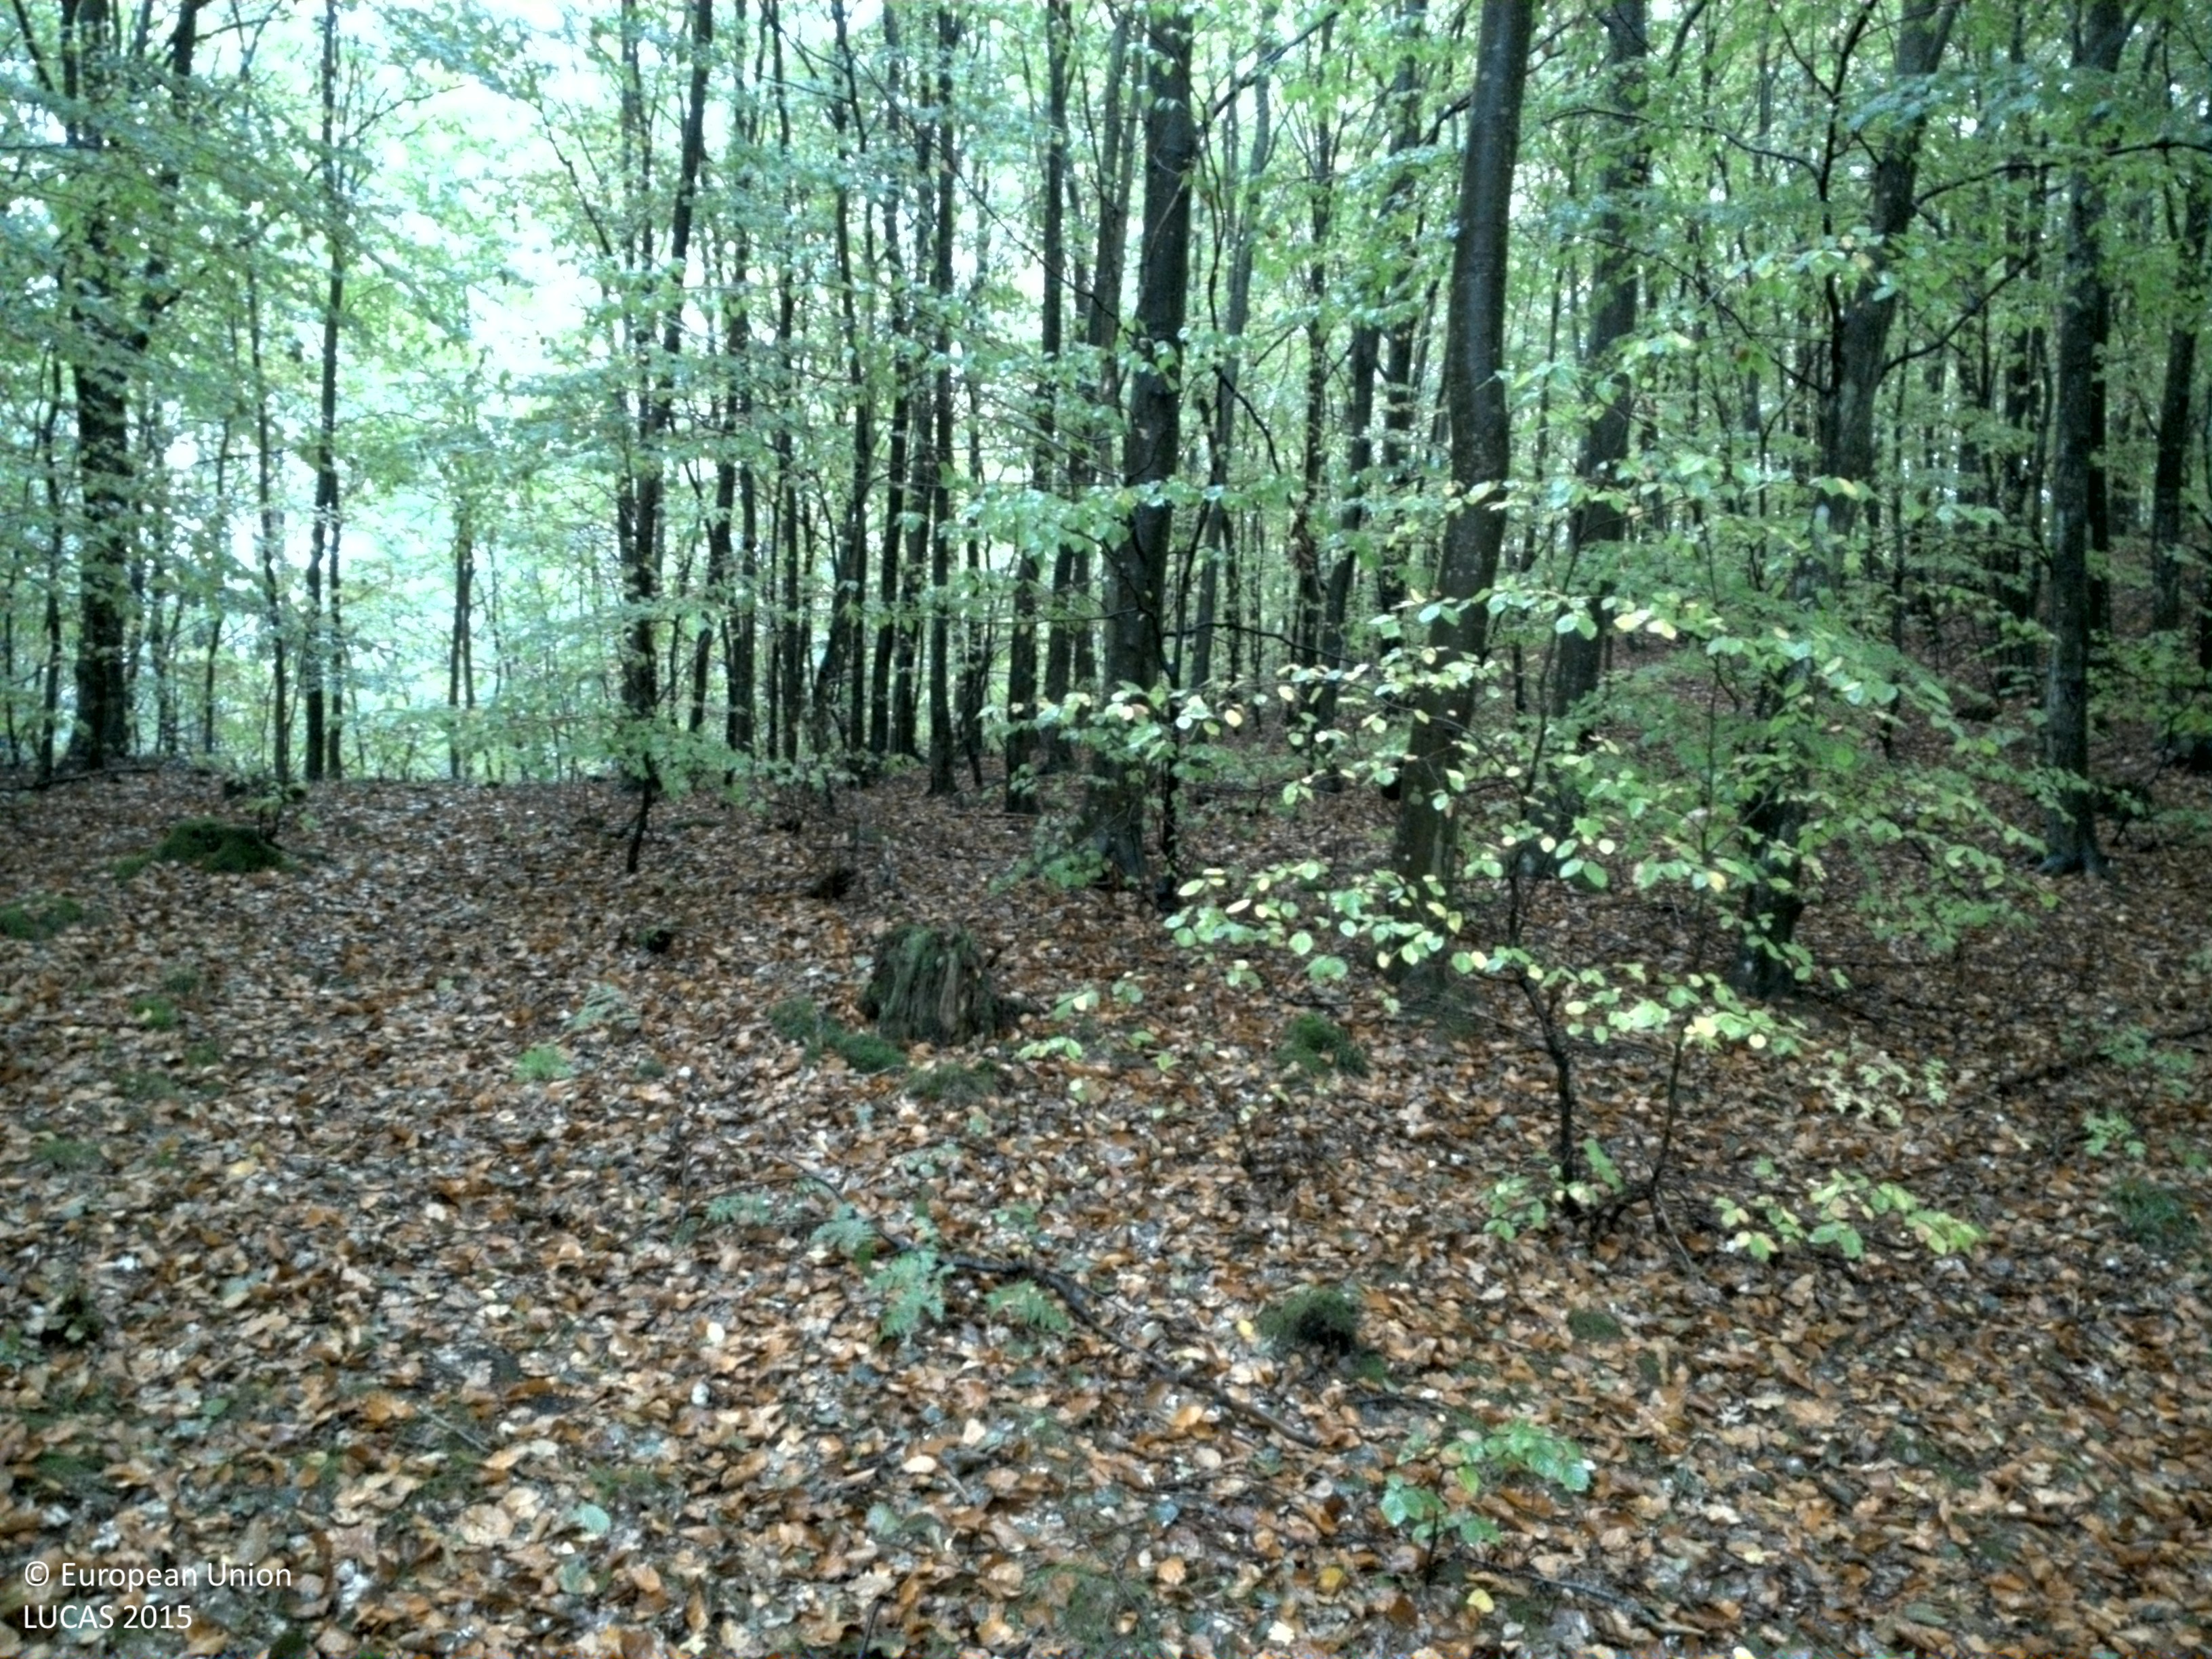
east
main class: Woodland
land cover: Broadleaved woodland
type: beech forest
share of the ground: > 75 %
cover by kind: broadleaved forest trees 80 %, unconsolidated bare surface 15 %, shrubs 5 %
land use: Forestry
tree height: > 5 m
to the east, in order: Broadleaved woodland; Paved roads, cycling and walking lanes; Grassland without tree/shrub cover; Broadleaved woodland
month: October
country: SE
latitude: 55.7276
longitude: 14.0586
